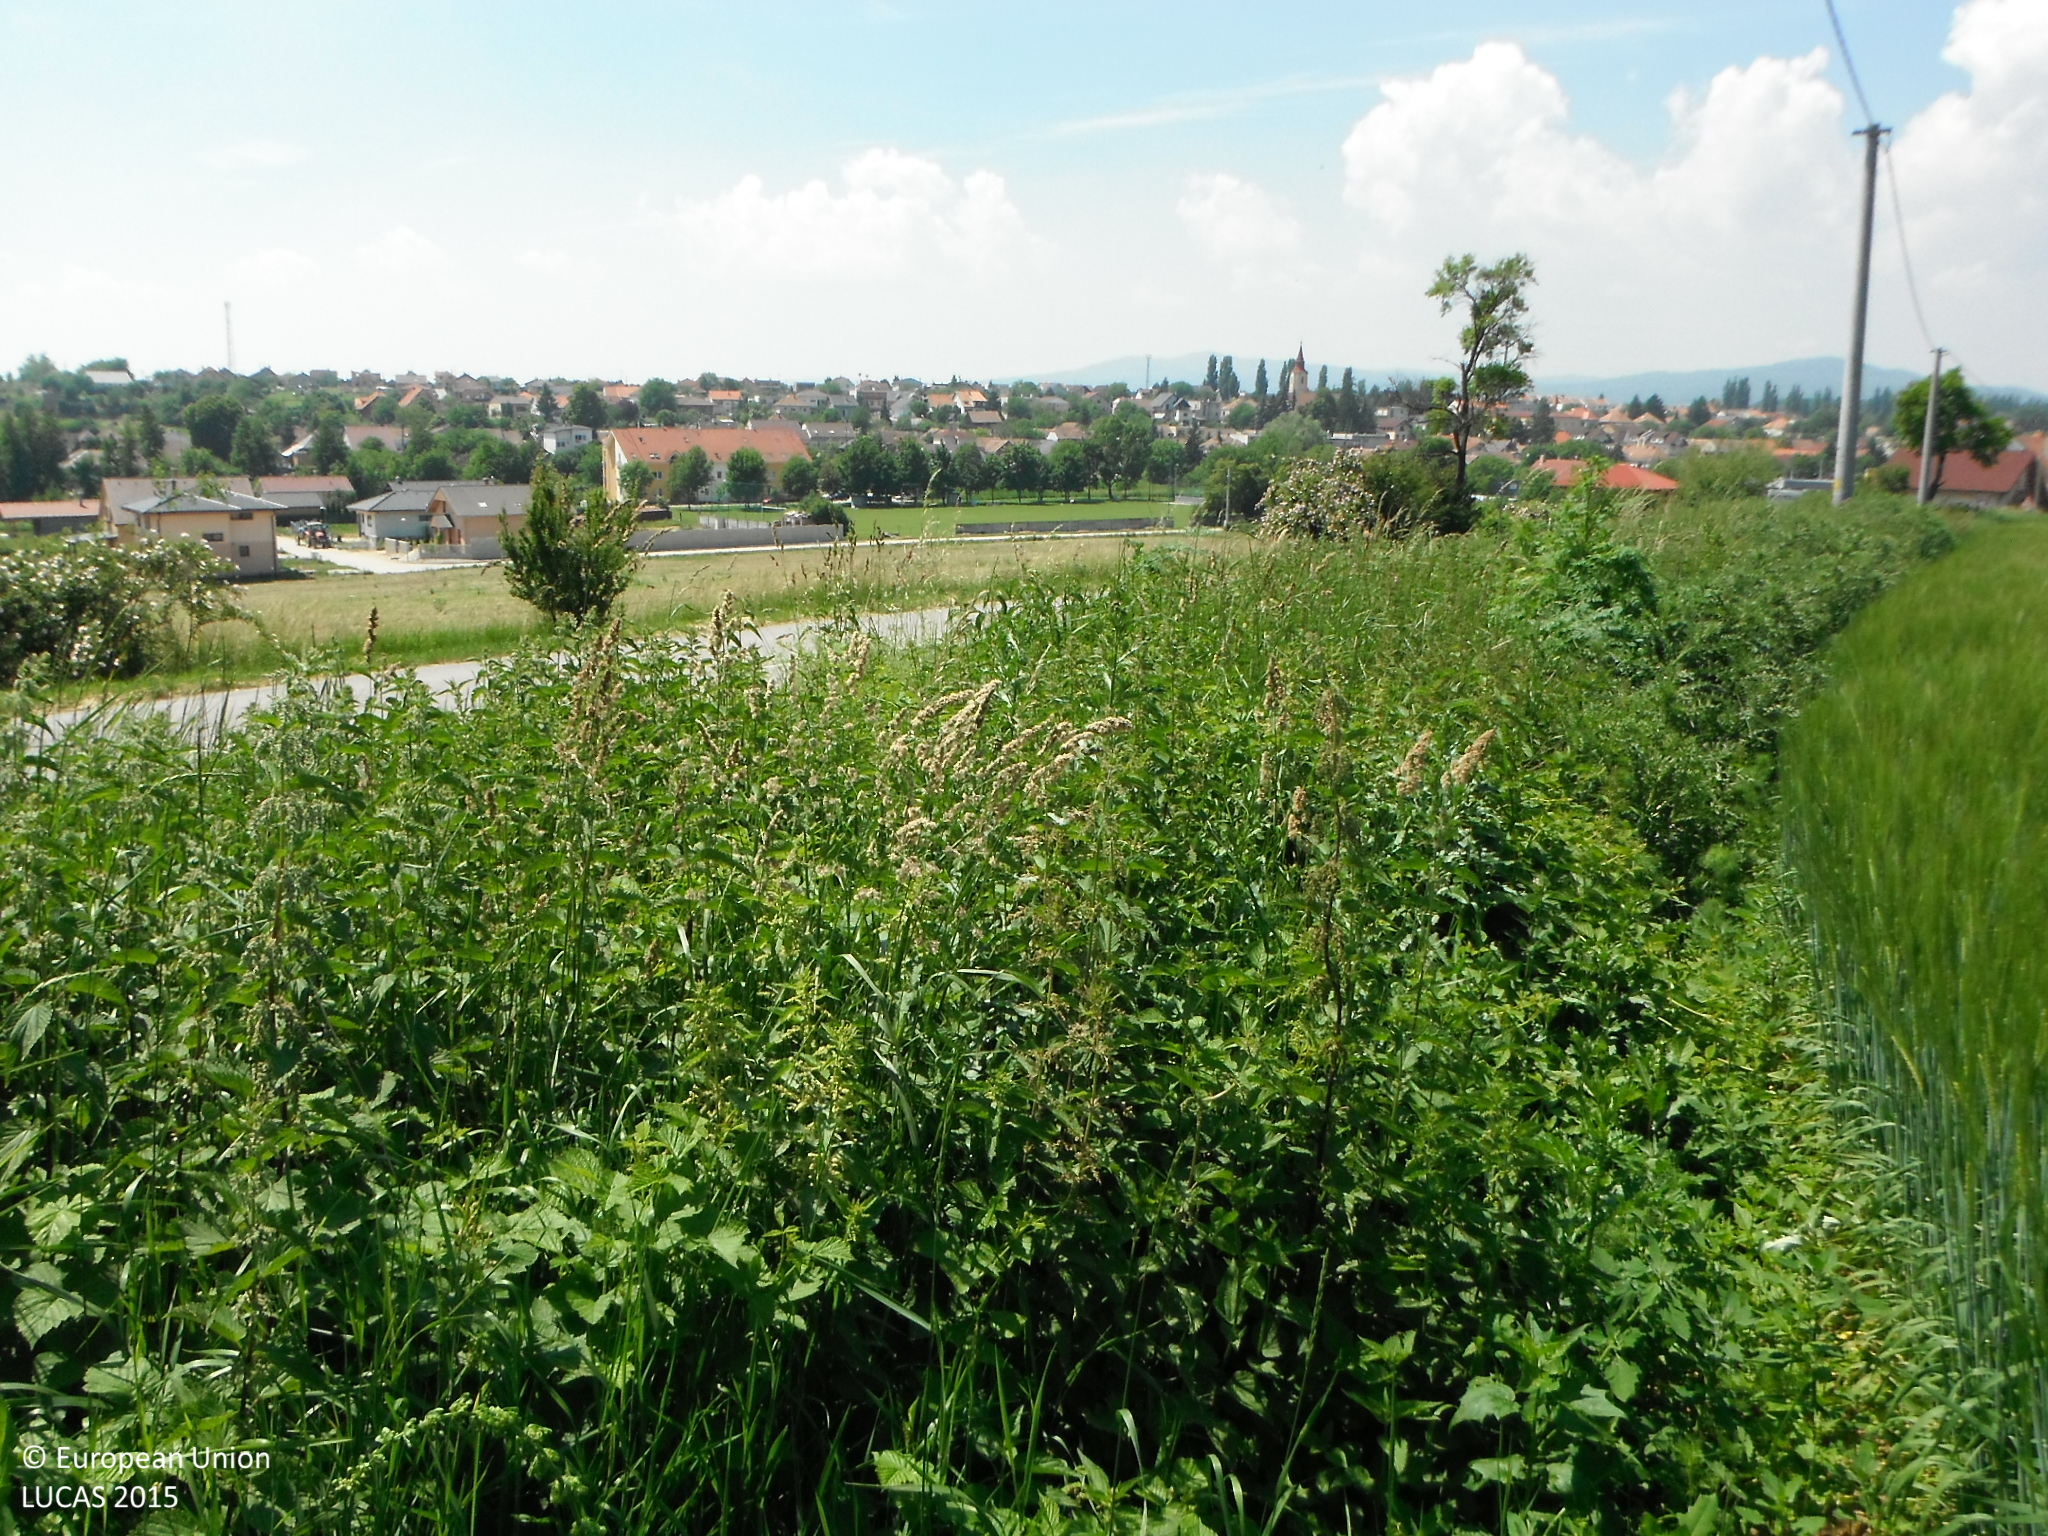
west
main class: Cropland
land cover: Barley
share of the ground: > 75 %
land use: Agriculture (excluding fallow land and kitchen gardens)
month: June
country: SK
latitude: 48.3529
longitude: 17.4185
